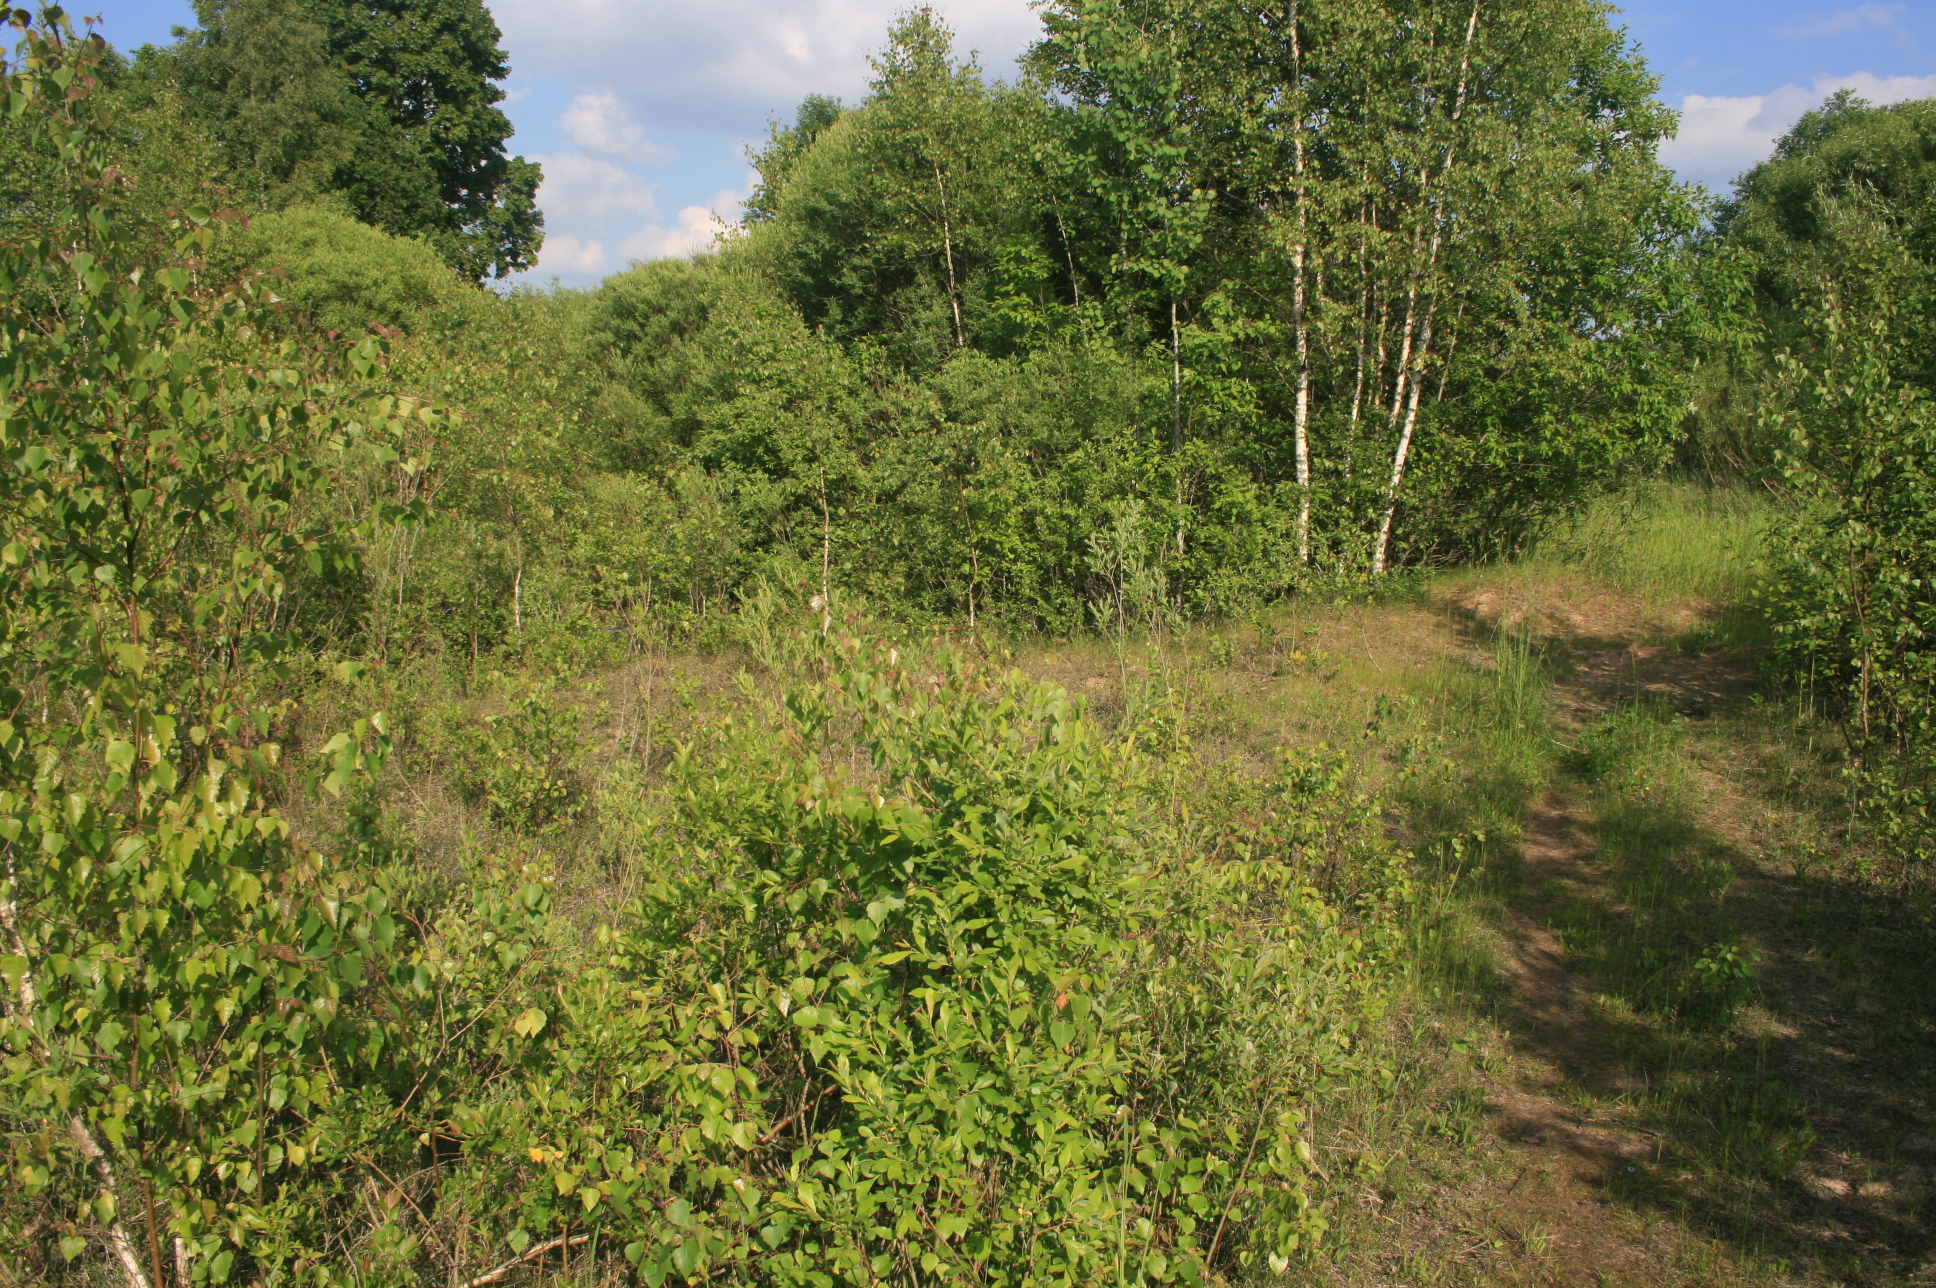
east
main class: Woodland
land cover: Broadleaved woodland
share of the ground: 50 - 75 %
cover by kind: broadleaved forest trees 60 %, herbaceous plants 25 %, unconsolidated bare surface 15 %
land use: Forestry
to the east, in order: Broadleaved woodland; Spontaneously vegetated surfaces; Grassland without tree/shrub cover; Shrubland without tree cover; Spontaneously vegetated surfaces; Single bushes/trees; Spontaneously vegetated surfaces; Broadleaved woodland; Grassland without tree/shrub cover
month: June
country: LT
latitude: 55.6385
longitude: 22.2091
